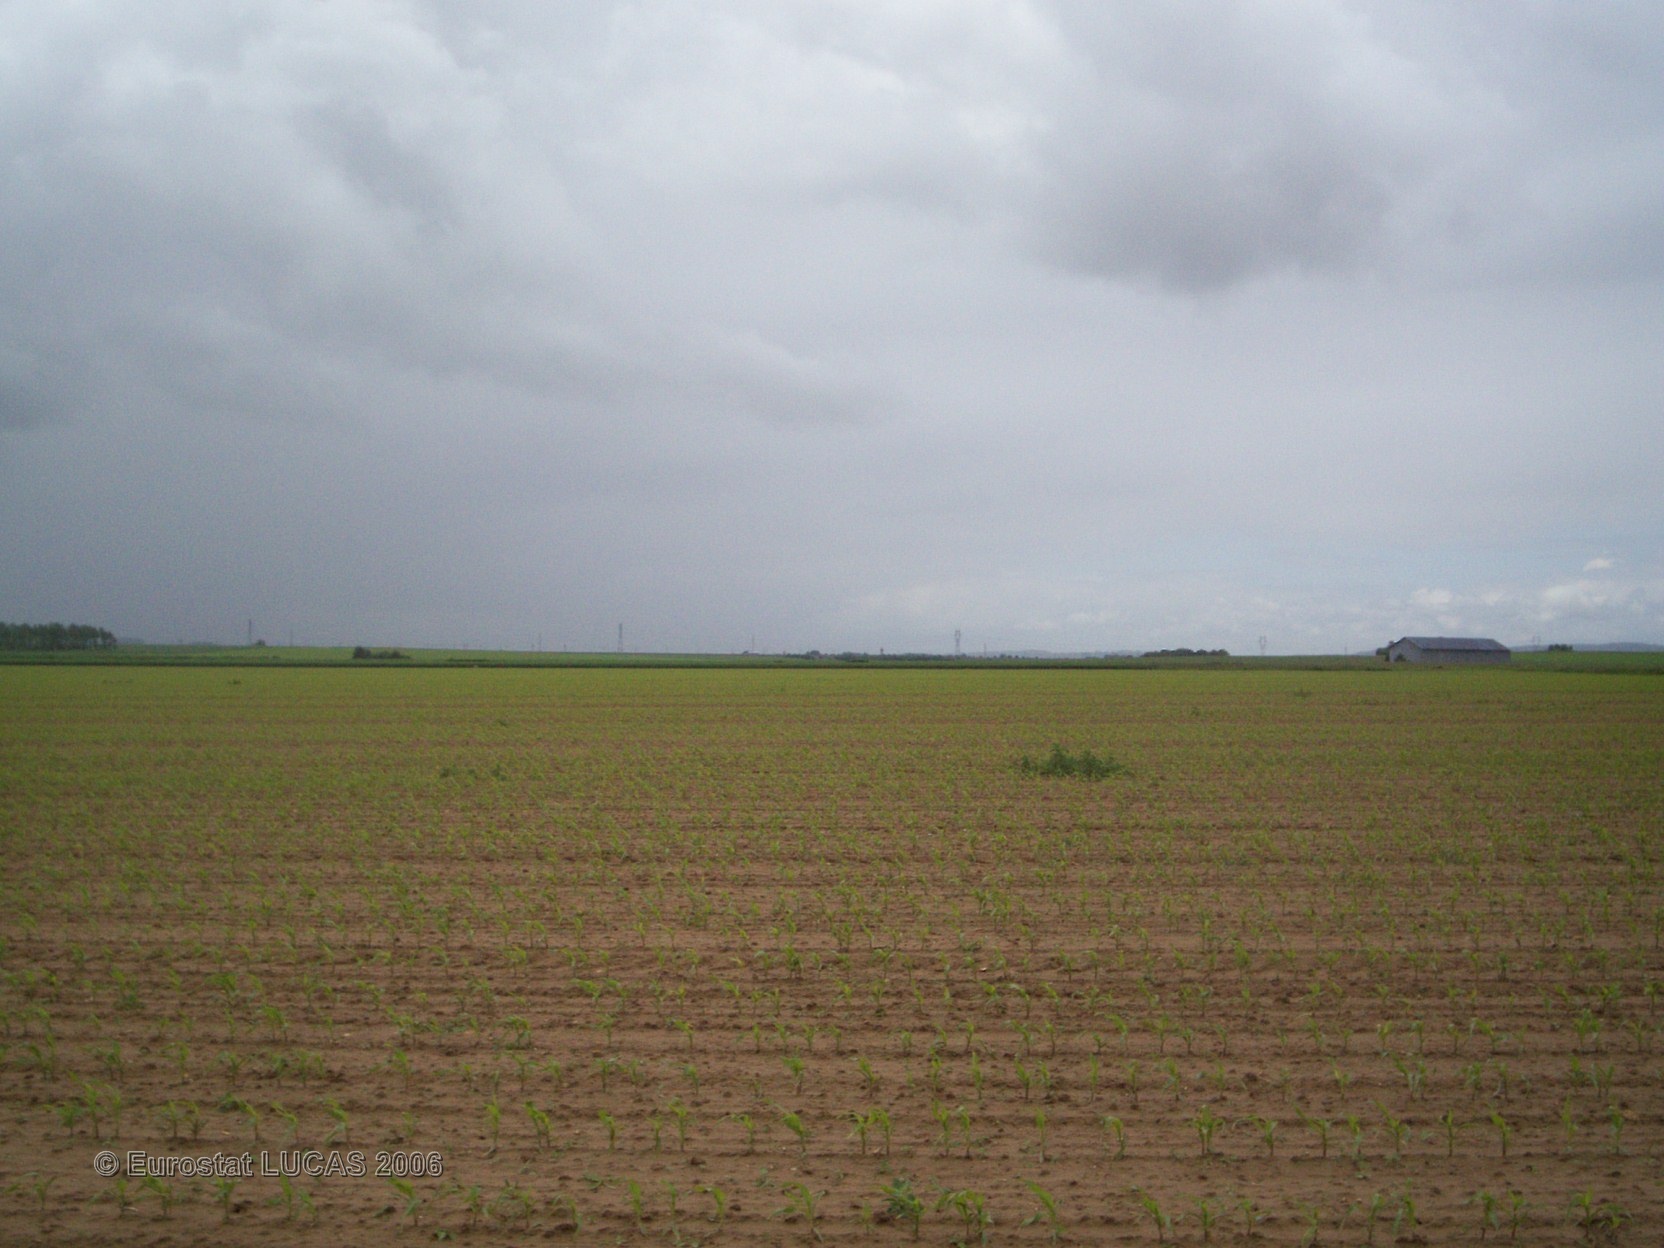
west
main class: Cropland
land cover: Maize
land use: Agriculture (excluding fallow land and kitchen gardens)
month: May
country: FR
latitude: 49.2330
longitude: 2.7798
